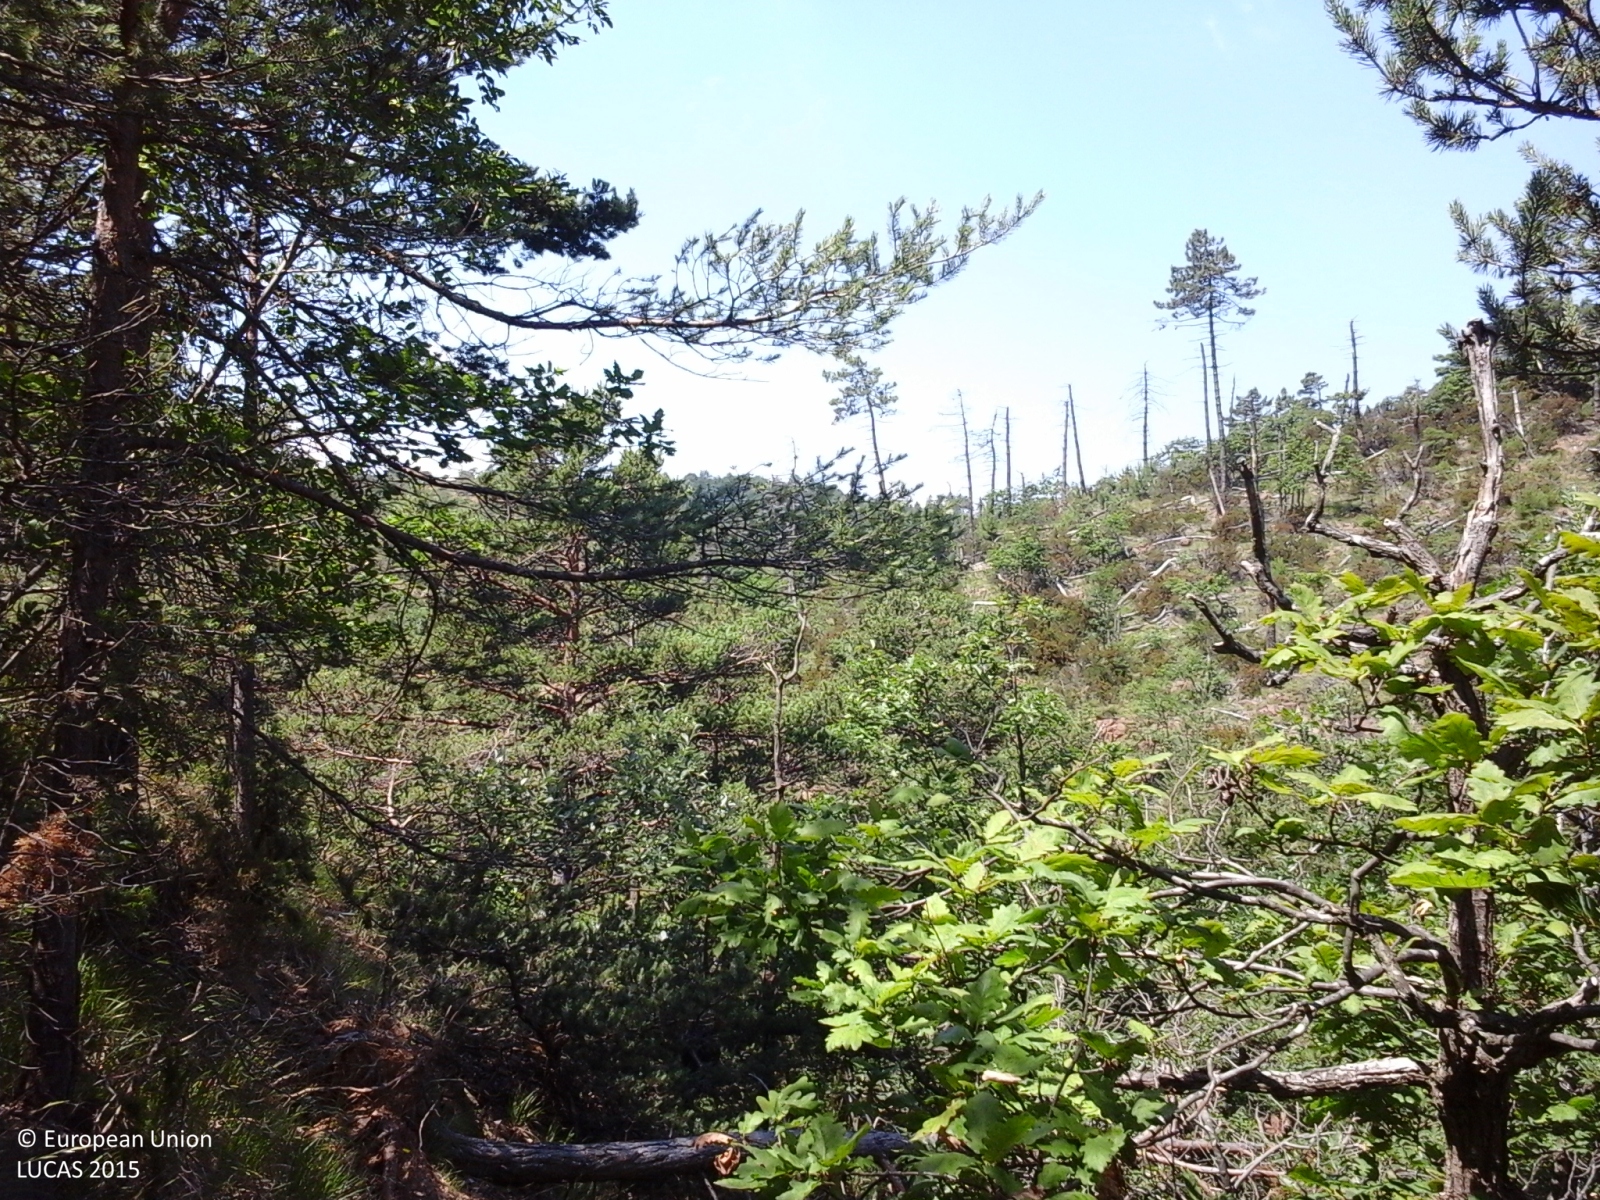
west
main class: Woodland
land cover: Pine dominated mixed woodland
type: coniferous forest of the mediterranean region
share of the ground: > 75 %
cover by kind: coniferous forest trees 45 %, broadleaved forest trees 25 %, shrubs 15 %, herbaceous plants 10 %, consolidated bare surface 5 %
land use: Forestry
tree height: > 5 m
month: June
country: IT
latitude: 44.5202
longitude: 8.5060
